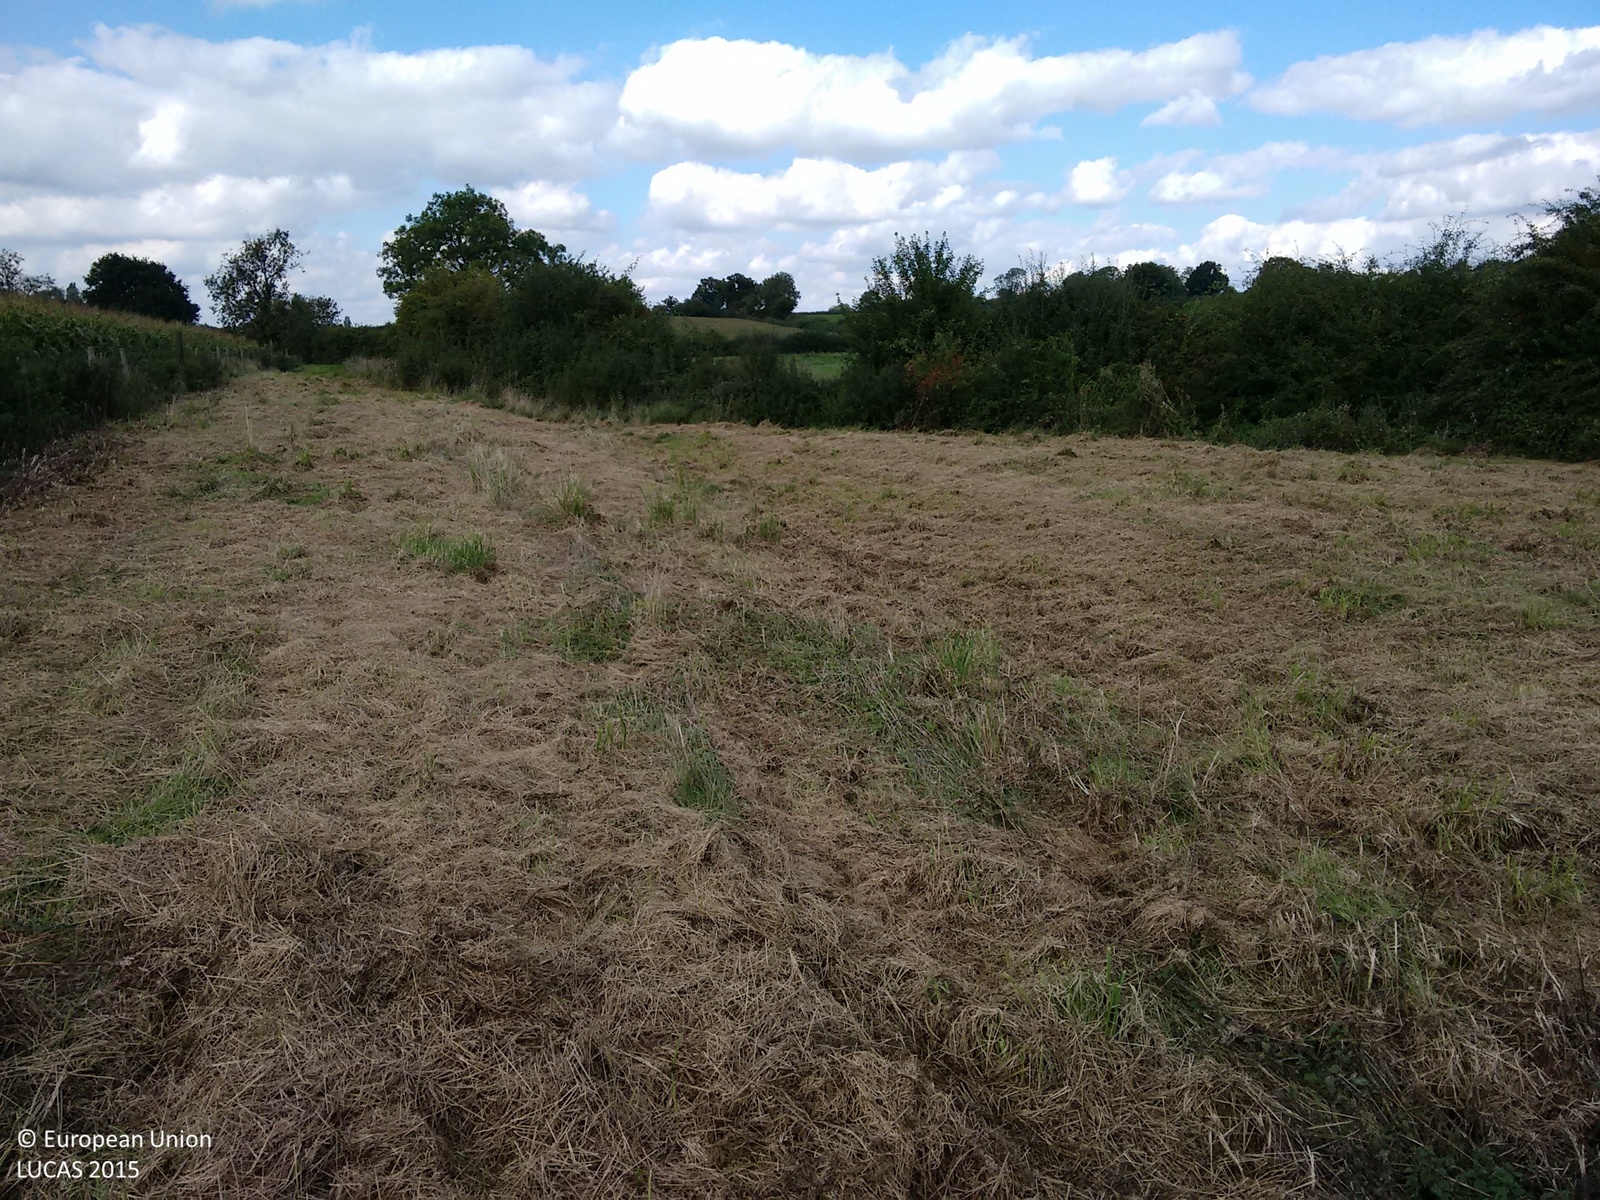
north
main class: Grassland
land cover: Grassland without tree/shrub cover
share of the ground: > 75 %
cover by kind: herbaceous plants 100 %
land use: Agriculture (excluding fallow land and kitchen gardens)
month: September
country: GB
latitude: 52.5298
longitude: 1.3268
